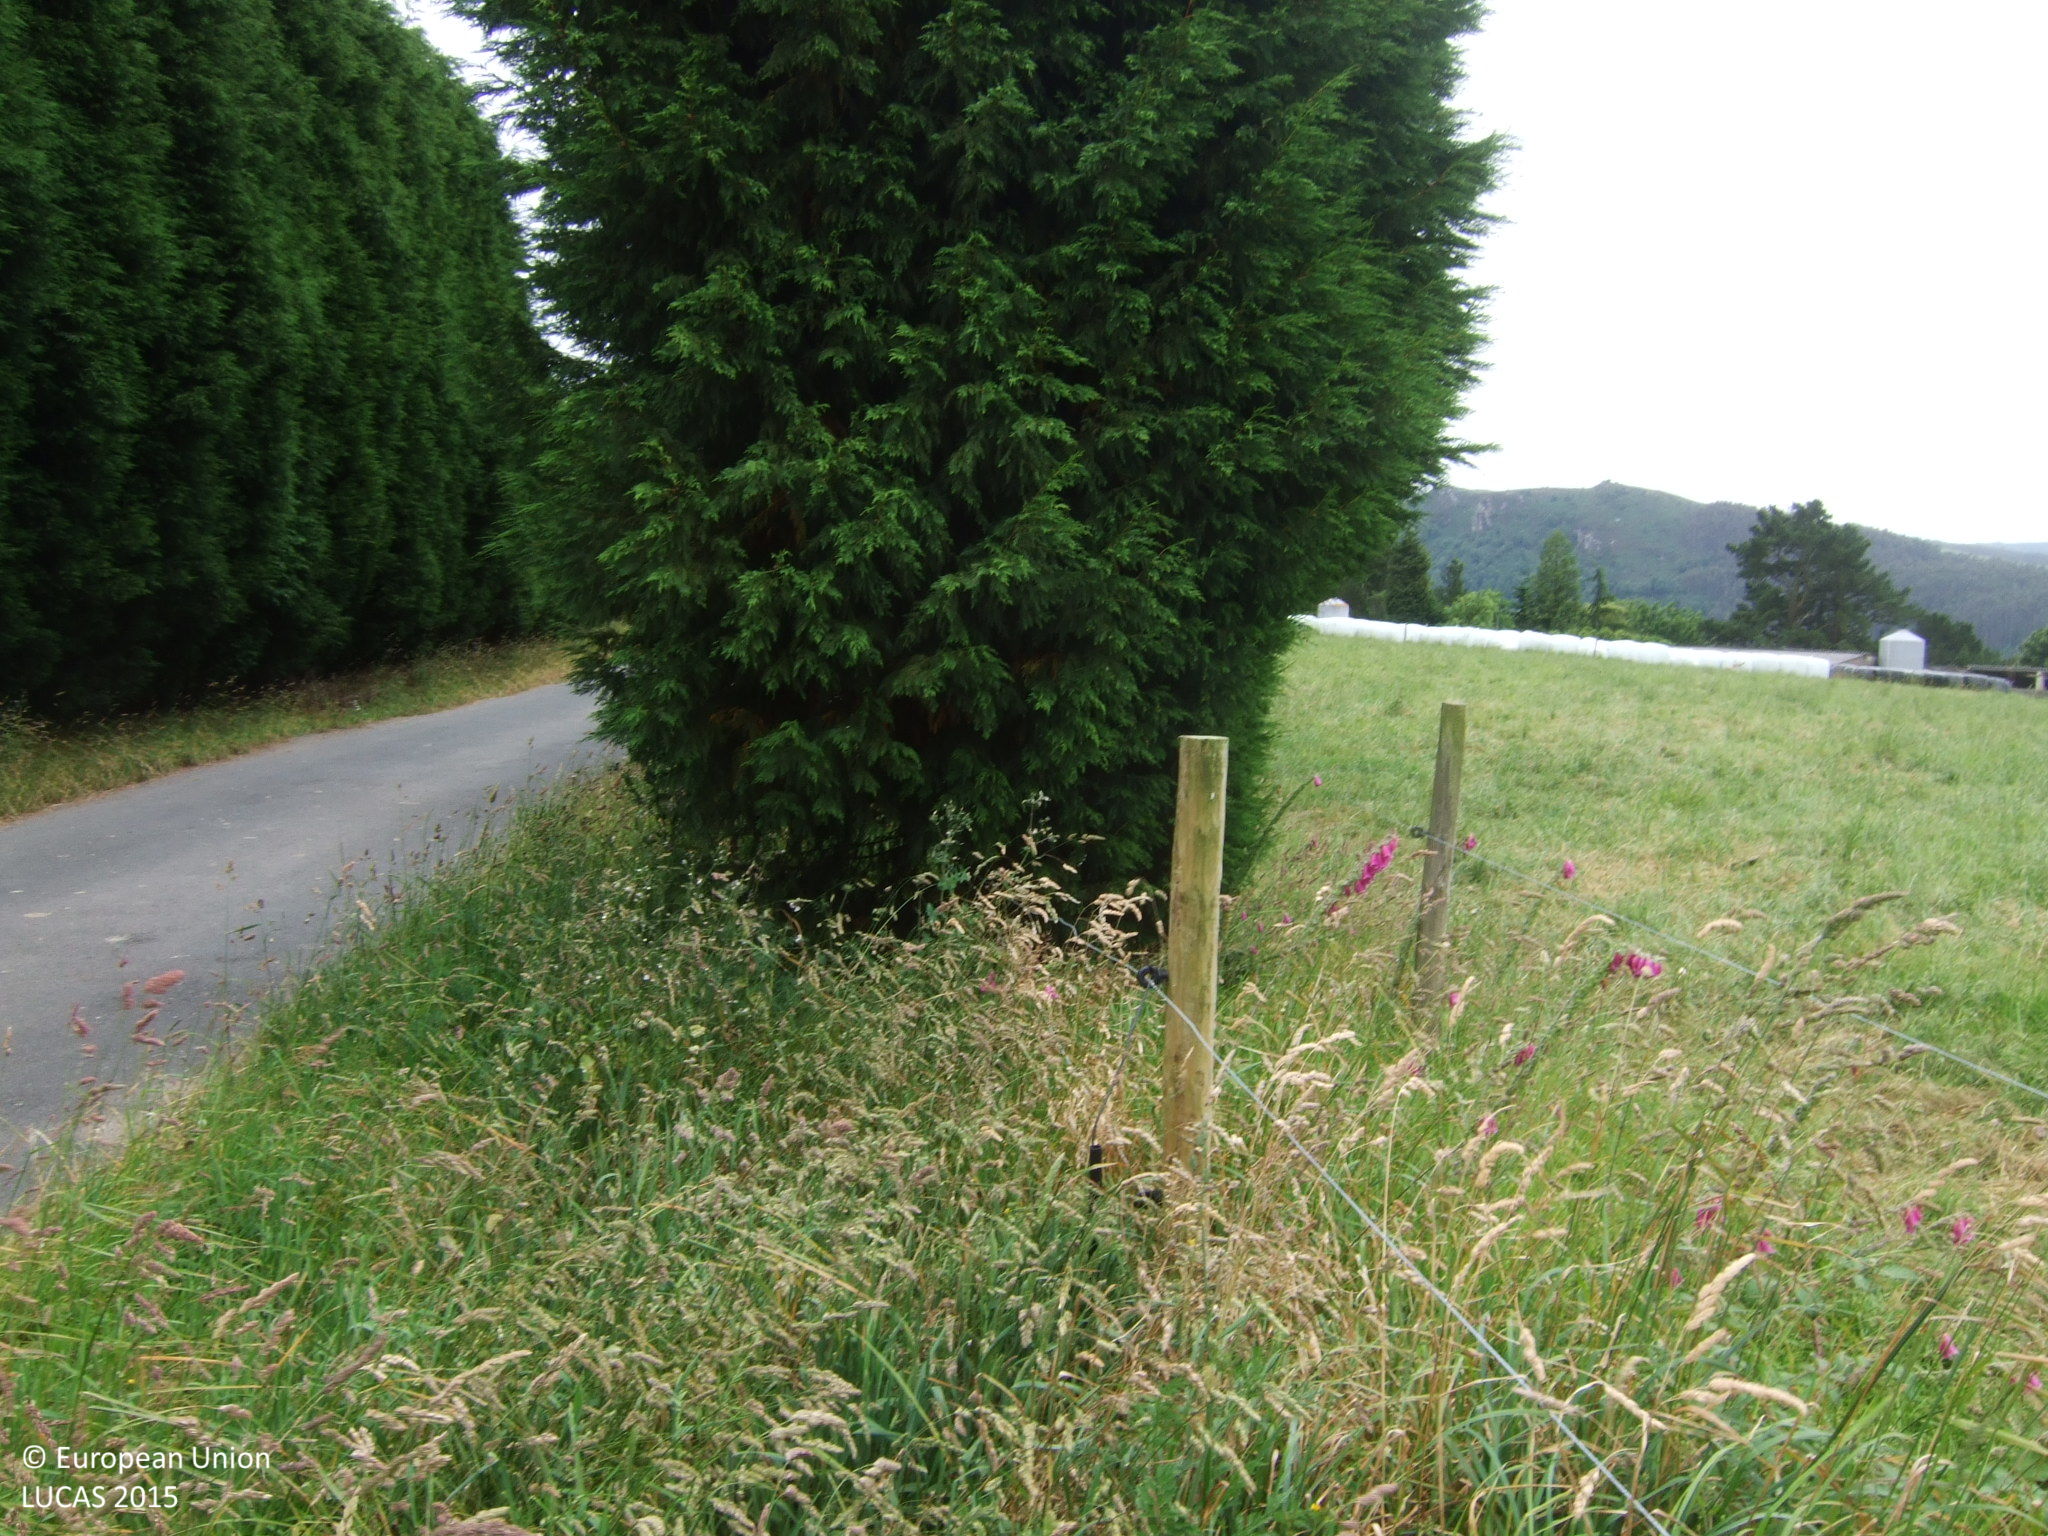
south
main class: Grassland
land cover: Grassland without tree/shrub cover
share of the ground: > 75 %
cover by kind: herbaceous plants 100 %
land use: Agriculture (excluding fallow land and kitchen gardens)
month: June
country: ES
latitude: 43.5997
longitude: -7.8445
